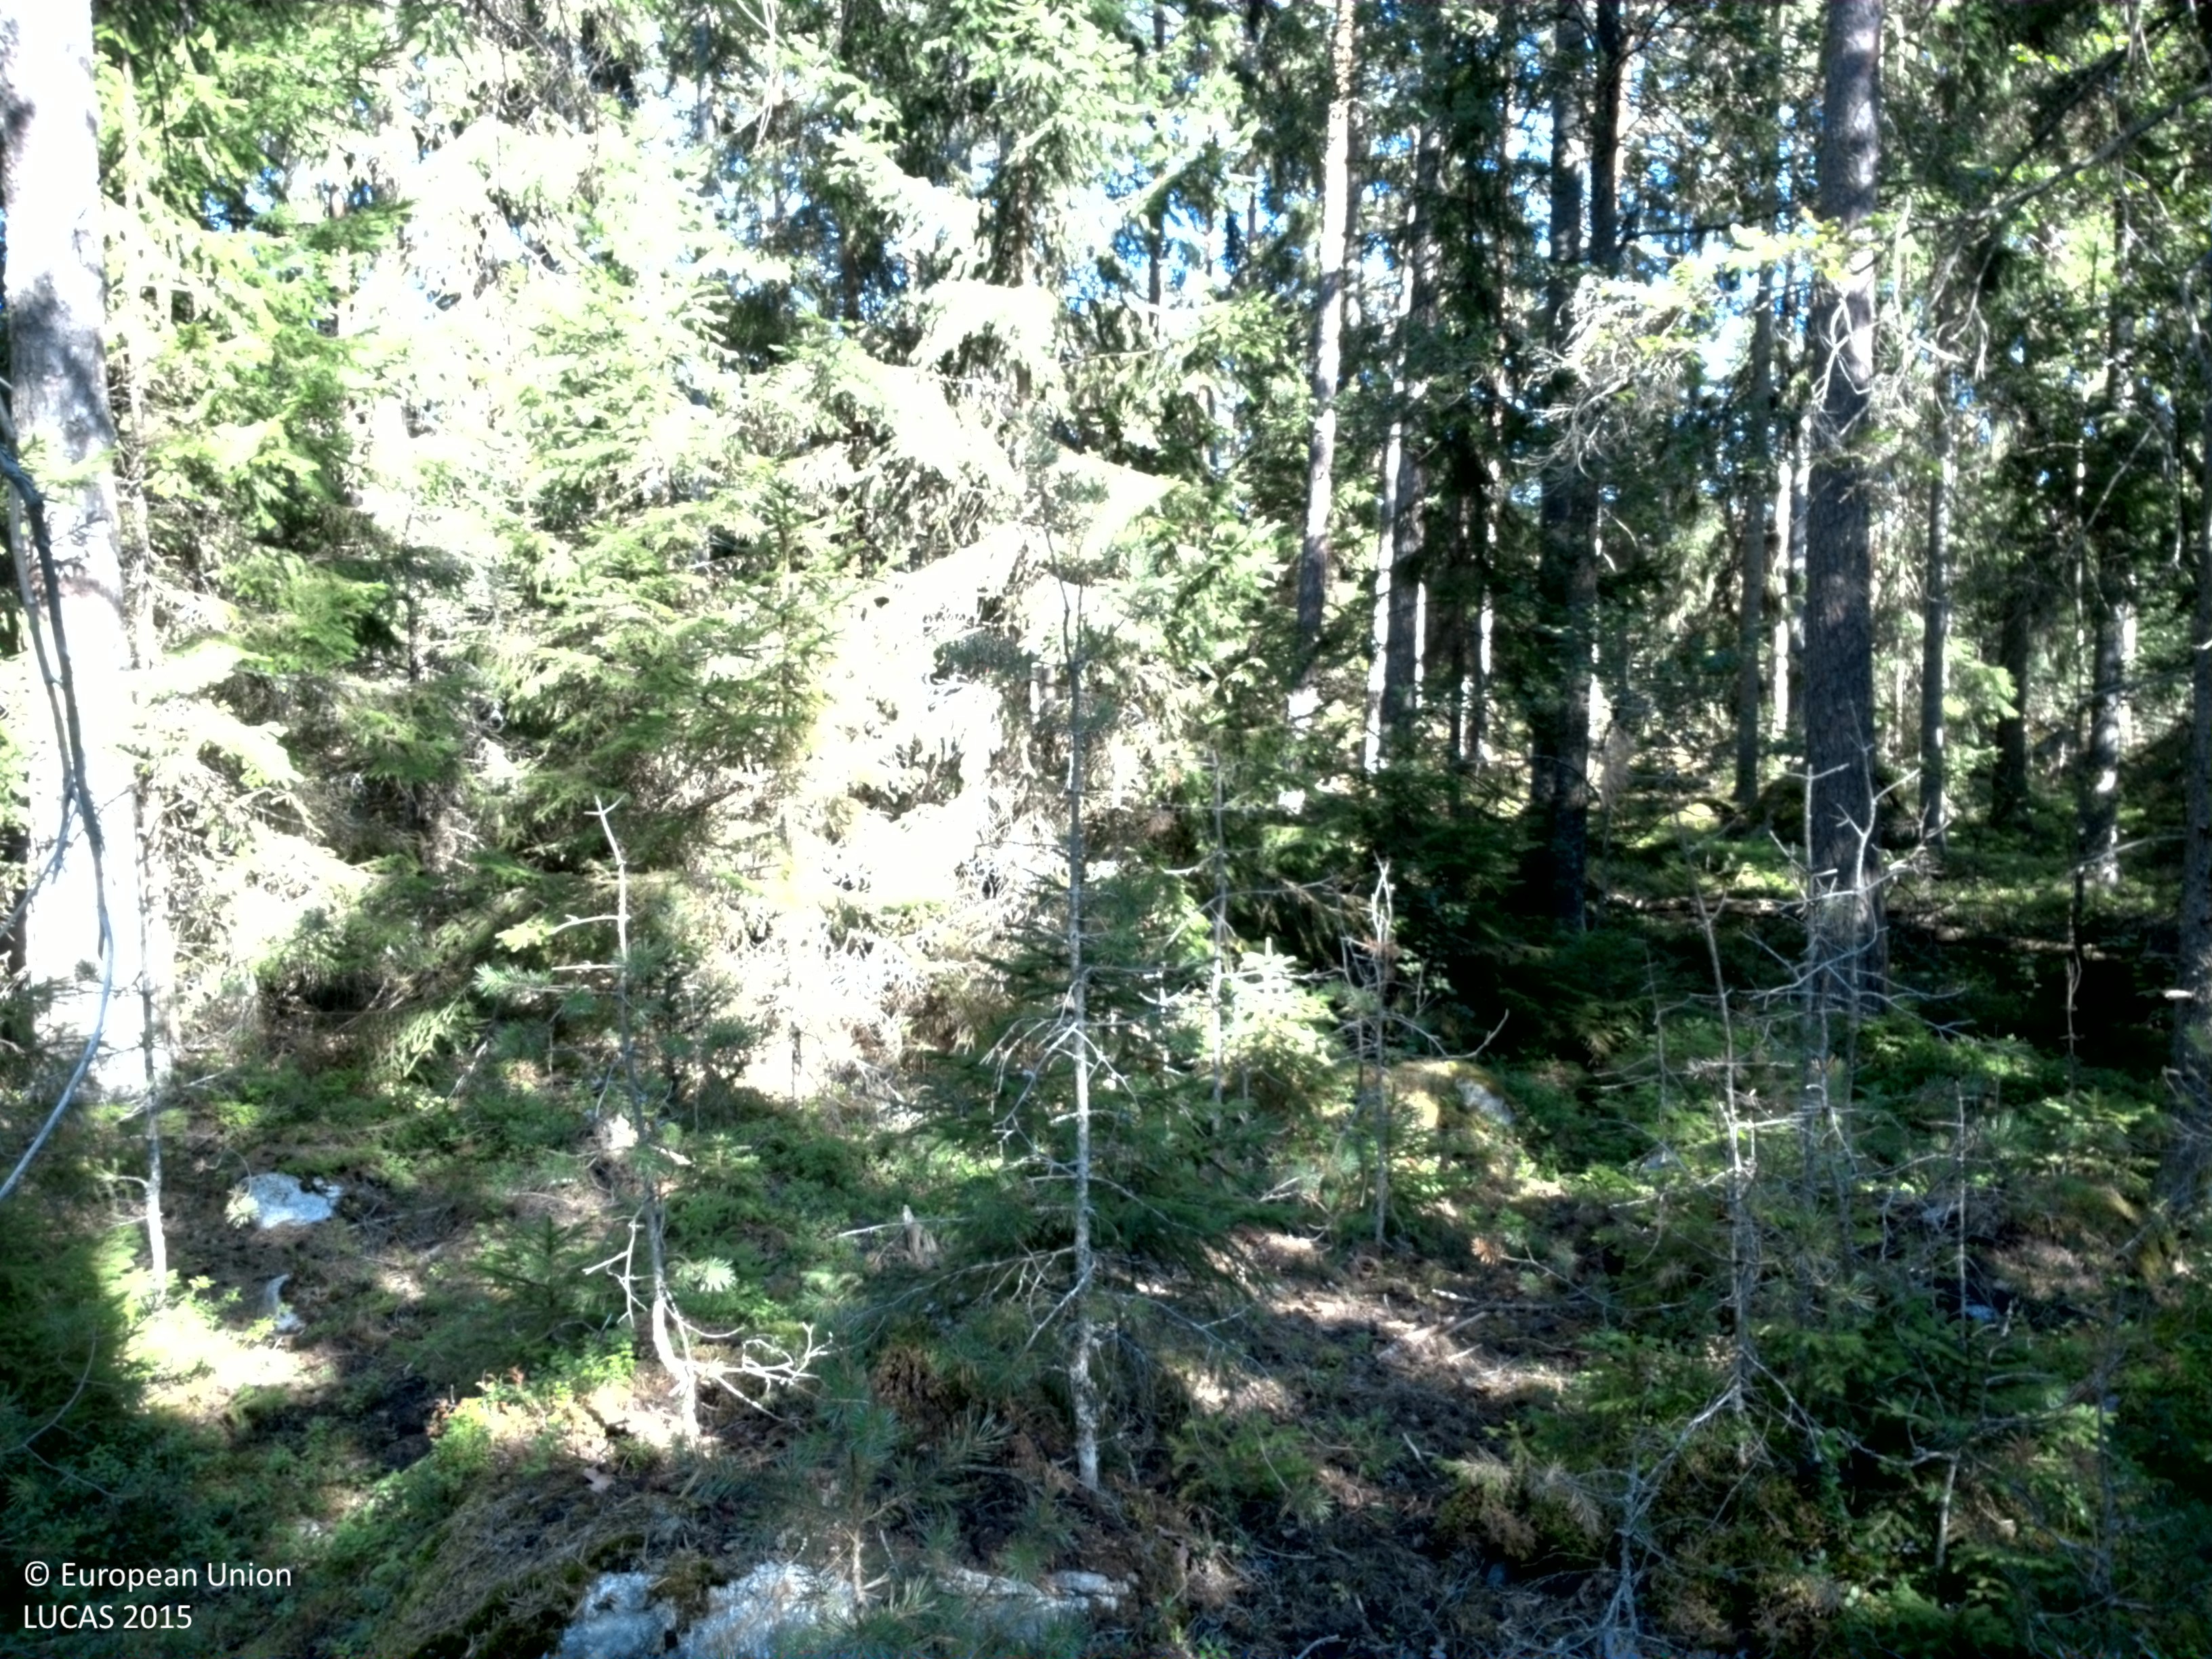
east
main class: Woodland
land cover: Other coniferous woodland
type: boreal forest
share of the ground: > 75 %
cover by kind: coniferous forest trees 85 %, lichens and mosses 15 %
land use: Amenities, museums, leisure
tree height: > 5 m
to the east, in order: Other coniferous woodland; Pine dominated coniferous woodland; Spruce dominated mixed woodland; Pine dominated coniferous woodland; Tracks; Pine dominated coniferous woodland
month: August
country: SE
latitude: 59.6872
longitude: 17.5796
